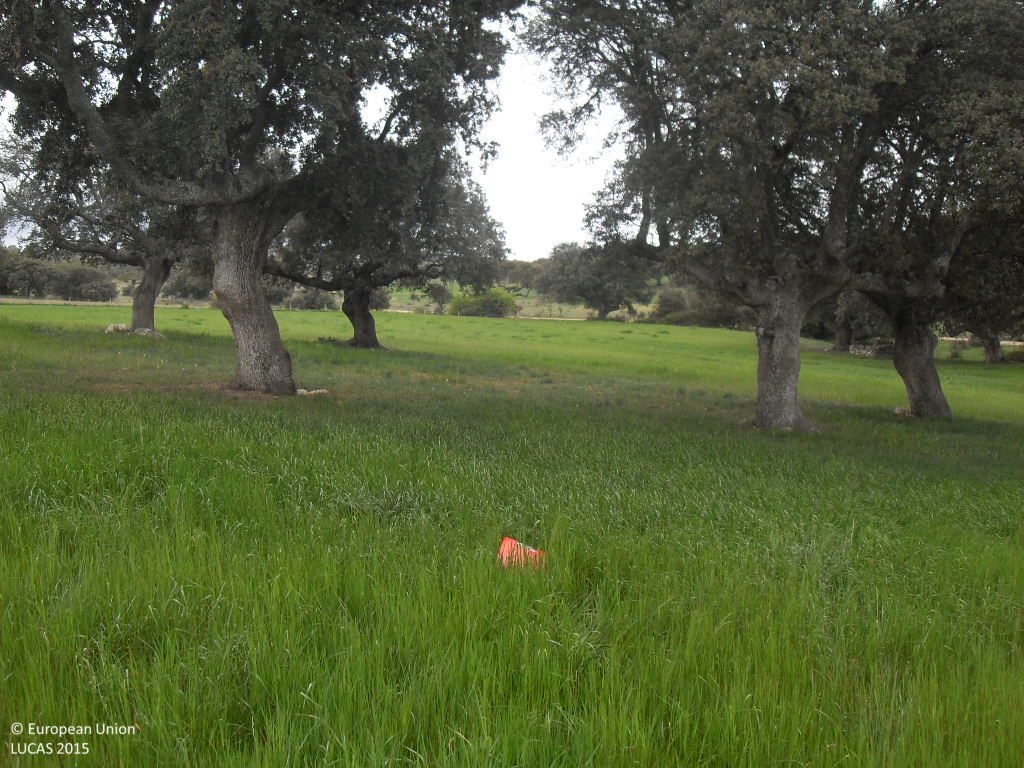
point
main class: Woodland
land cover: Broadleaved woodland
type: broadleaved evergreen forest
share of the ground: 10 - 25 %
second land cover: Temporary grasslands
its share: > 75 %
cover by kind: herbaceous plants 80 %, broadleaved forest trees 20 %
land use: Forestry
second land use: Agriculture (excluding fallow land and kitchen gardens)
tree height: > 5 m
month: April
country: ES
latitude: 40.6912
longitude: -5.3201
